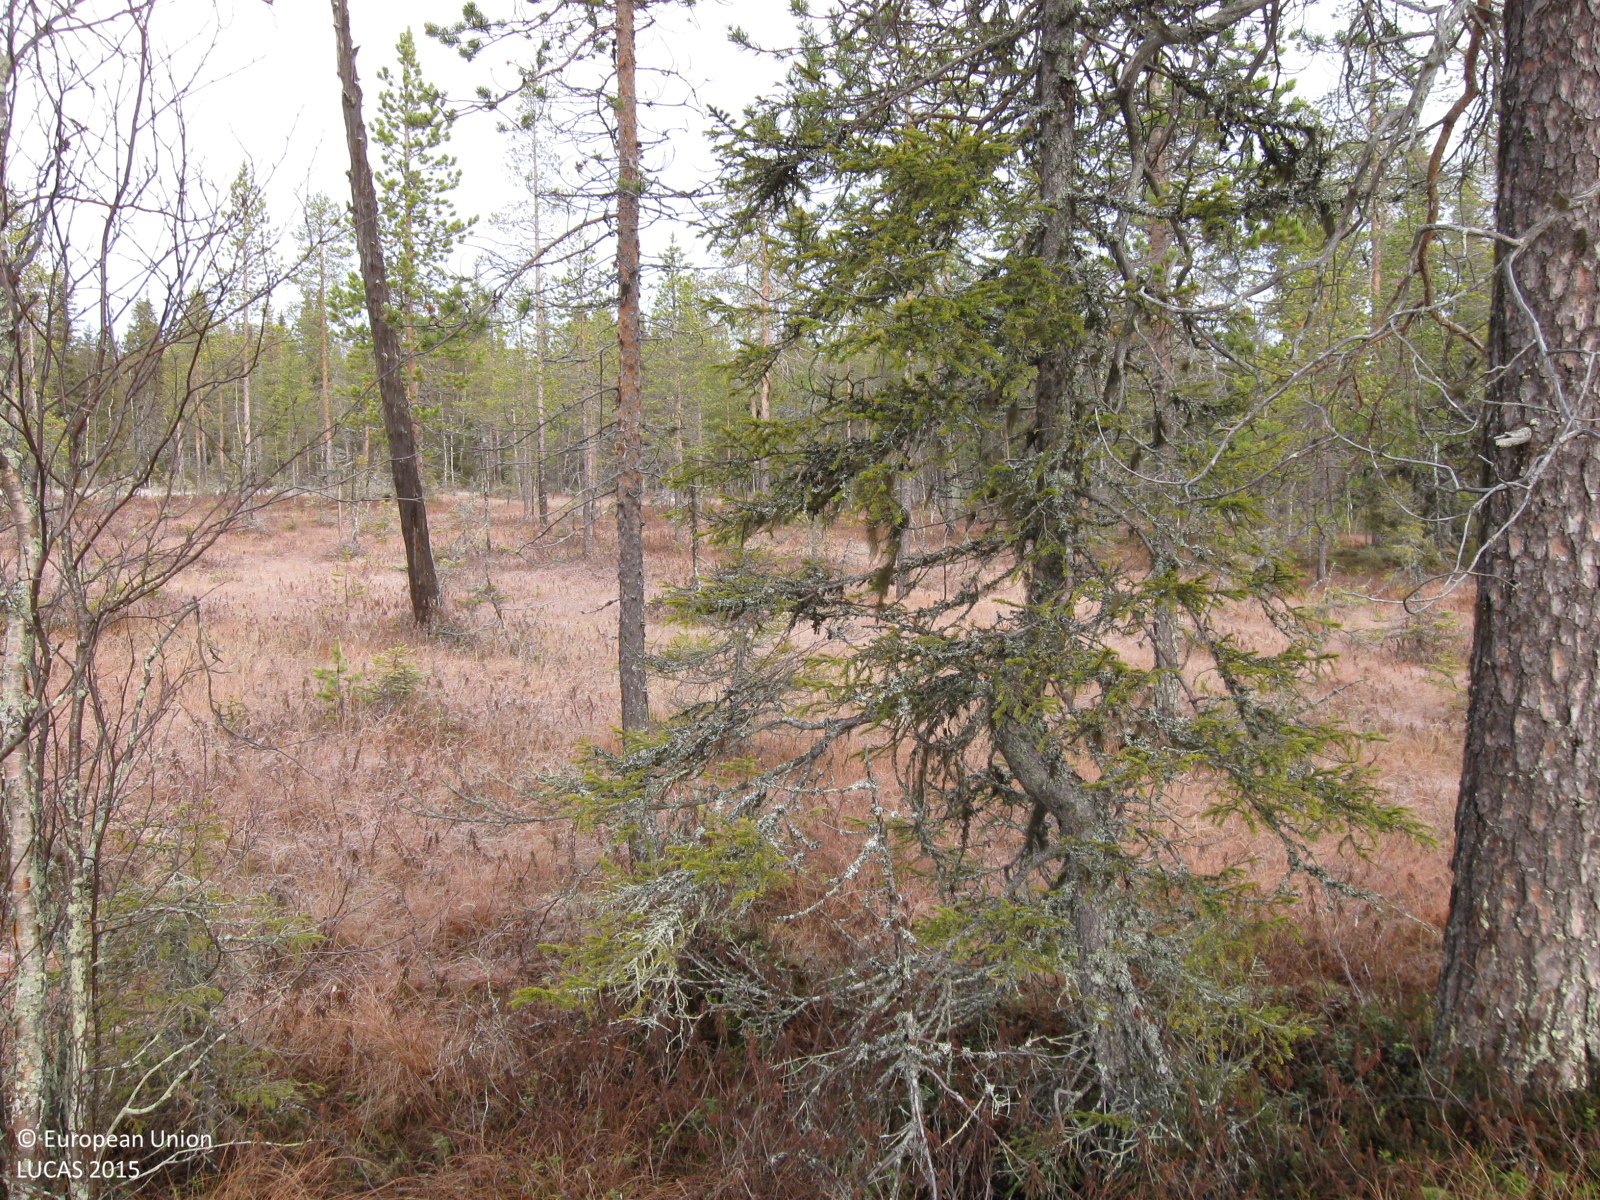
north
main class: Woodland
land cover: Pine dominated coniferous woodland
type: mire and swamp forests
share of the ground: 25 - 50 %
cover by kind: coniferous forest trees 35 %, herbaceous plants 30 %, shrubs 15 %, broadleaved forest trees 10 %, lichens and mosses 10 %
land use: Forestry
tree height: > 5 m
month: October
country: SE
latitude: 66.5031
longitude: 21.5383
